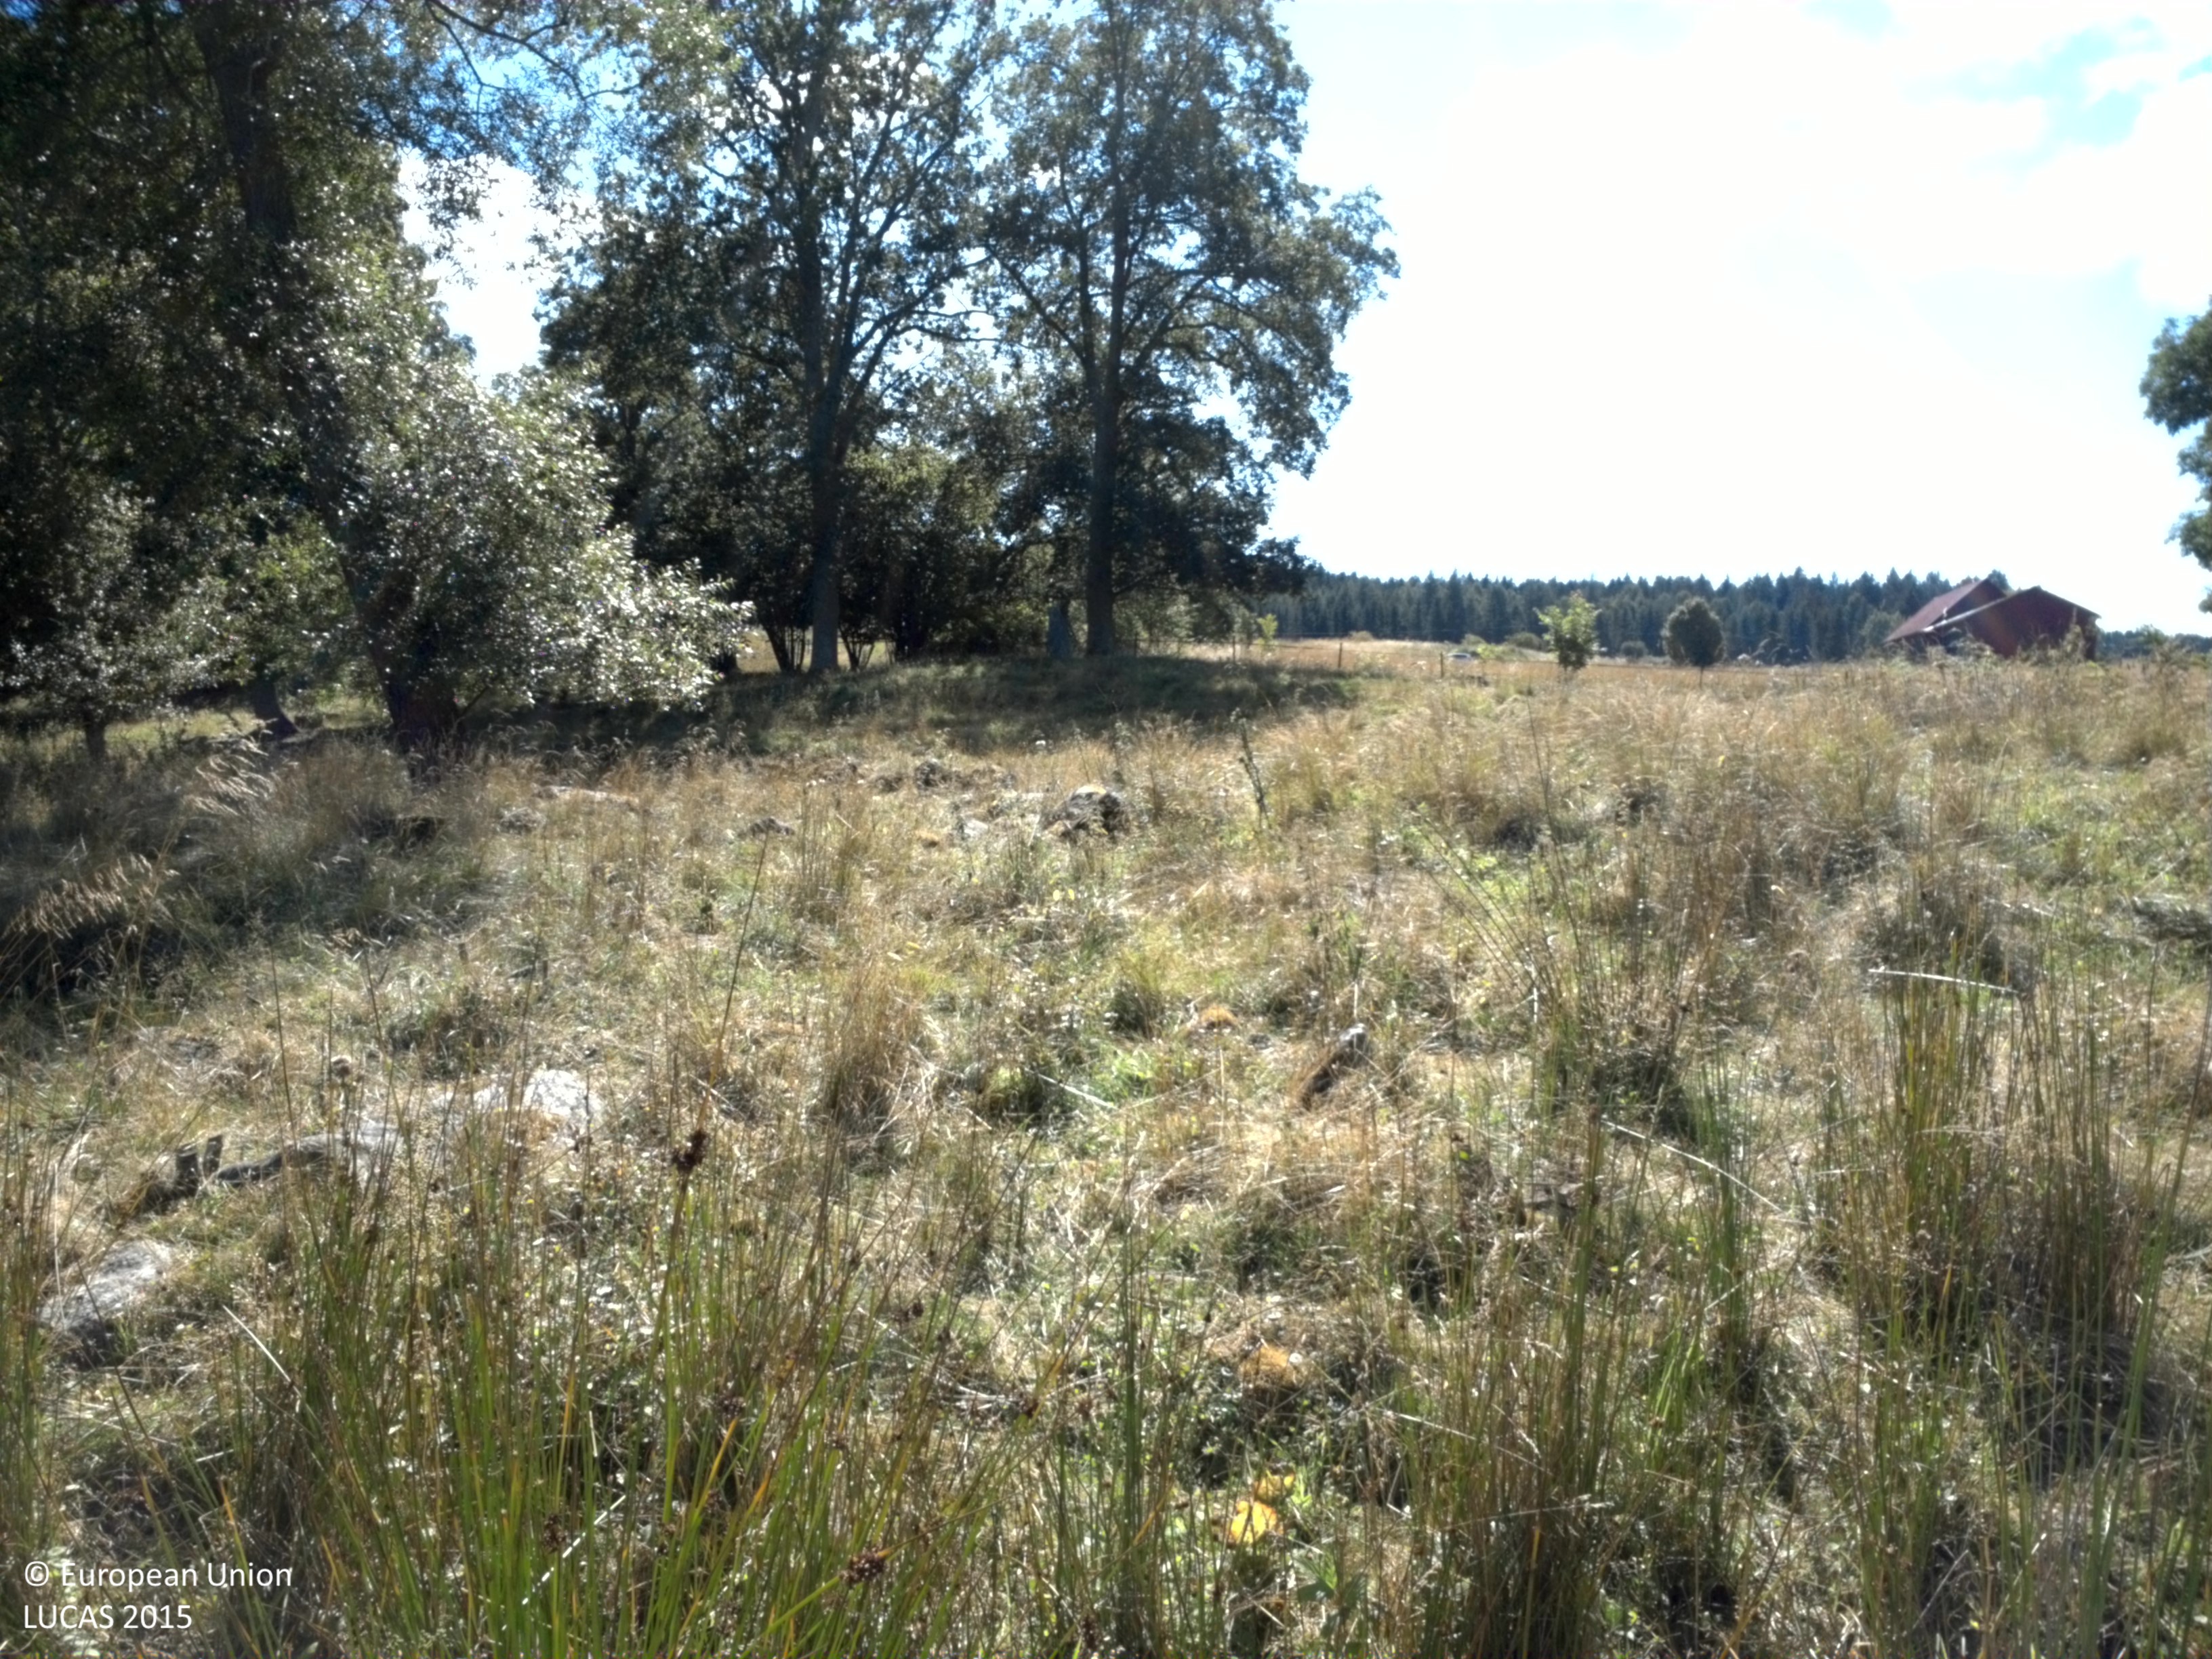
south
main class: Grassland
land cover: Grassland with sparse tree/shrub cover
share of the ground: > 75 %
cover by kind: herbaceous plants 95 %, broadleaved forest trees 5 %
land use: Agriculture (excluding fallow land and kitchen gardens)
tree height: > 5 m
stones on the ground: < 10 %
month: August
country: SE
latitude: 59.6515
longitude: 17.5717
